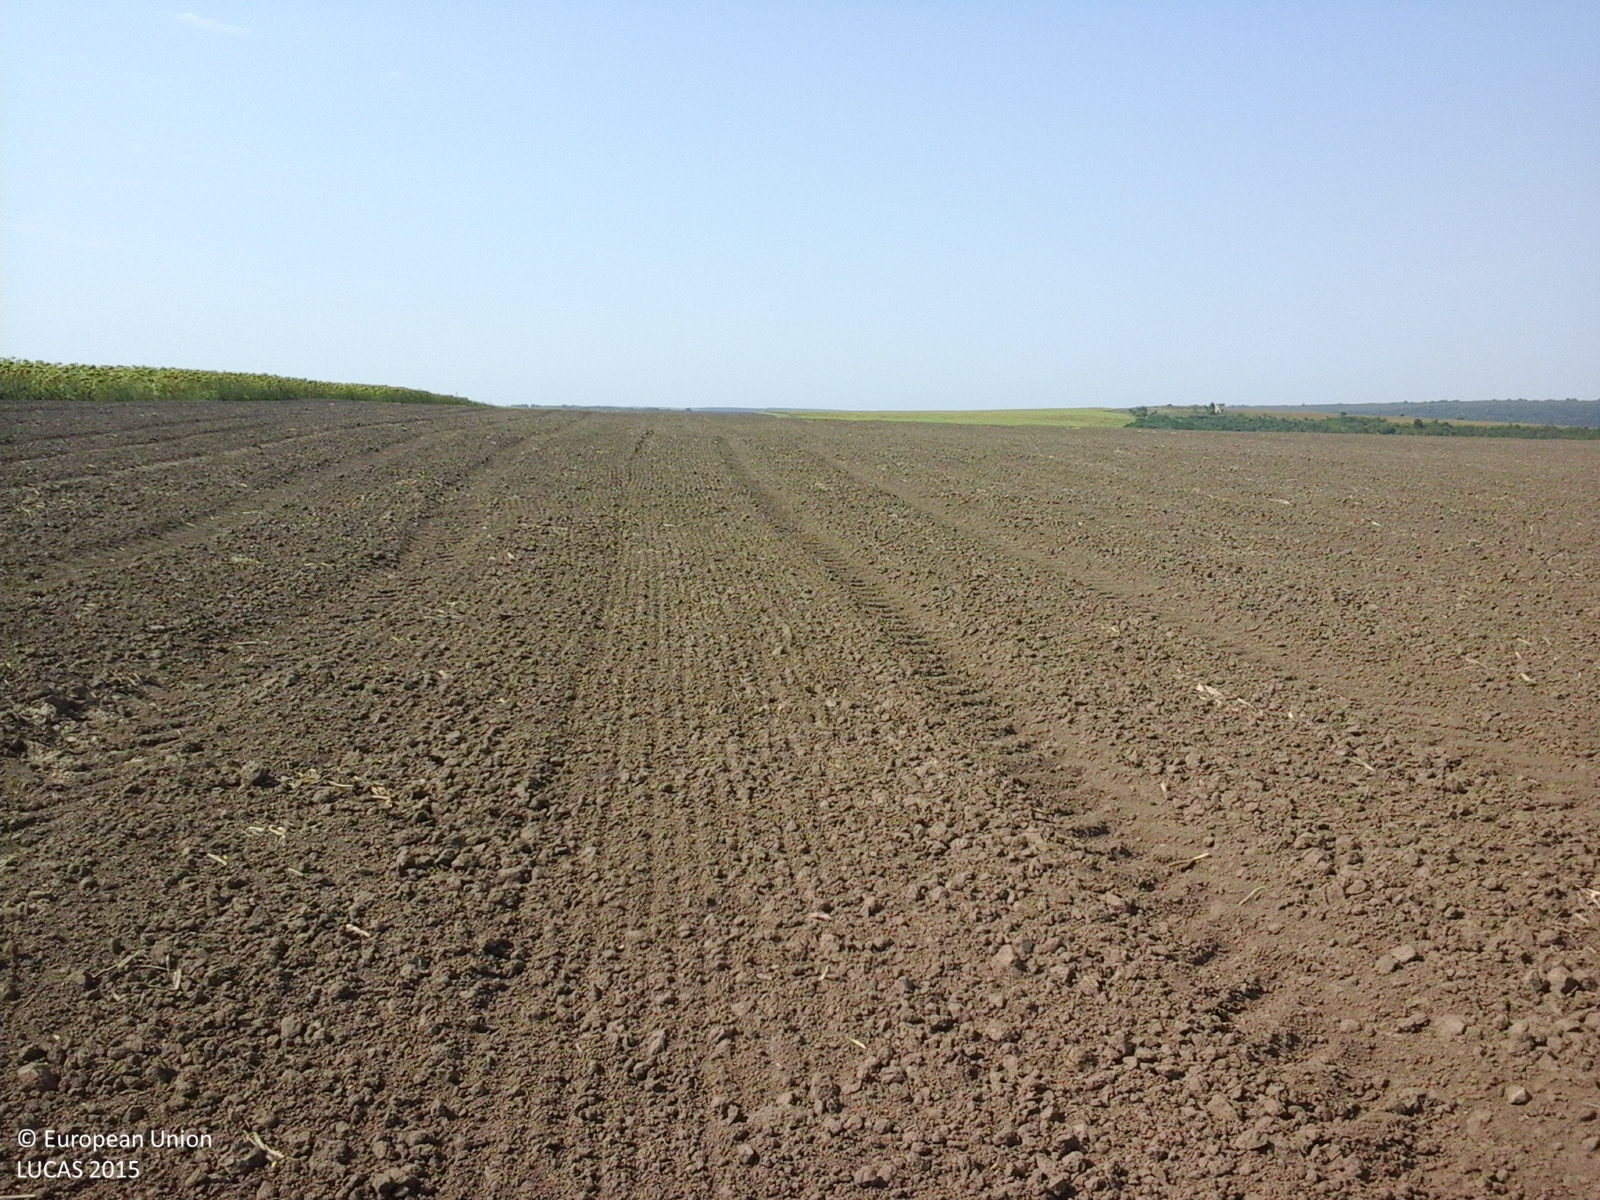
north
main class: Cropland
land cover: Common wheat
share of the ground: < 10 %
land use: Agriculture (excluding fallow land and kitchen gardens)
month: August
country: RO
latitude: 43.9054
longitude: 27.9929
